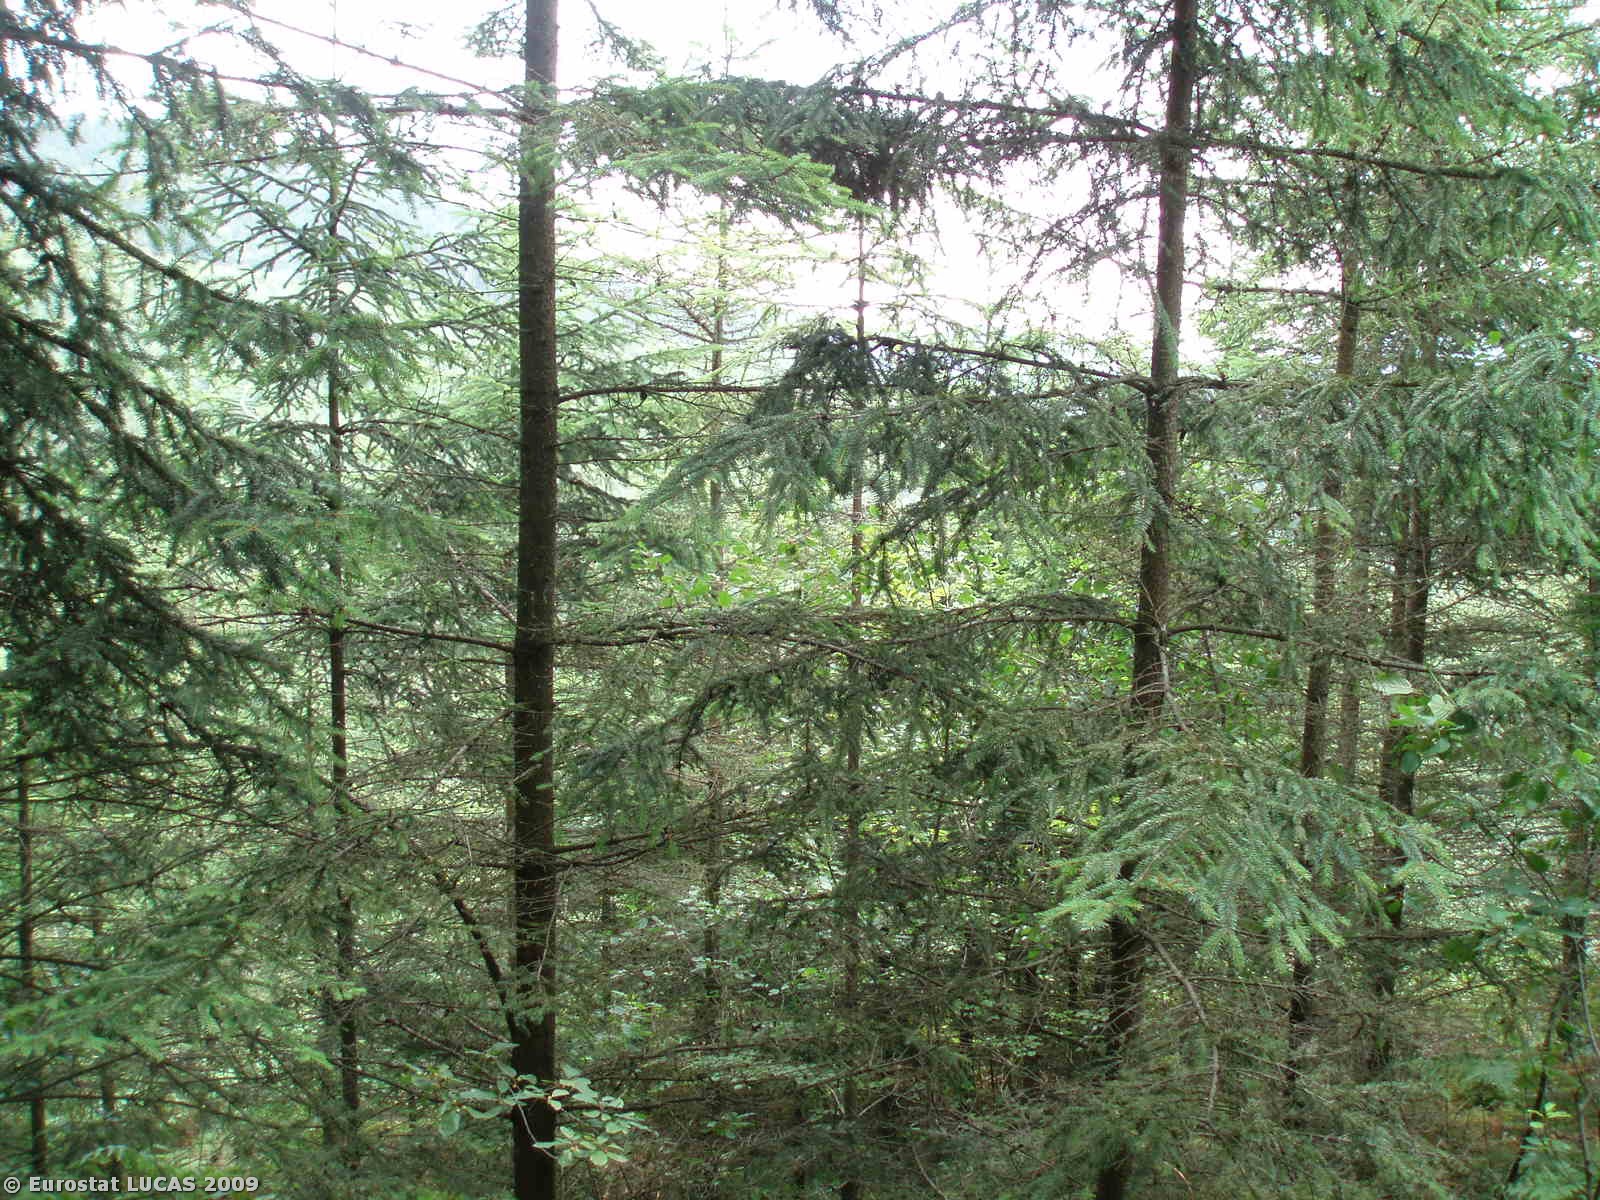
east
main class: Woodland
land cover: Mixed woodland
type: beech forest
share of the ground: > 75 %
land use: Forestry
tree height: > 5 m
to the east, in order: Mixed woodland; Coniferous woodland; Mixed woodland; Tracks; Mixed woodland; Broadleaved woodland; Tracks; Coniferous woodland; Mixed woodland
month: July
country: CZ
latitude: 50.7906
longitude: 14.2145
